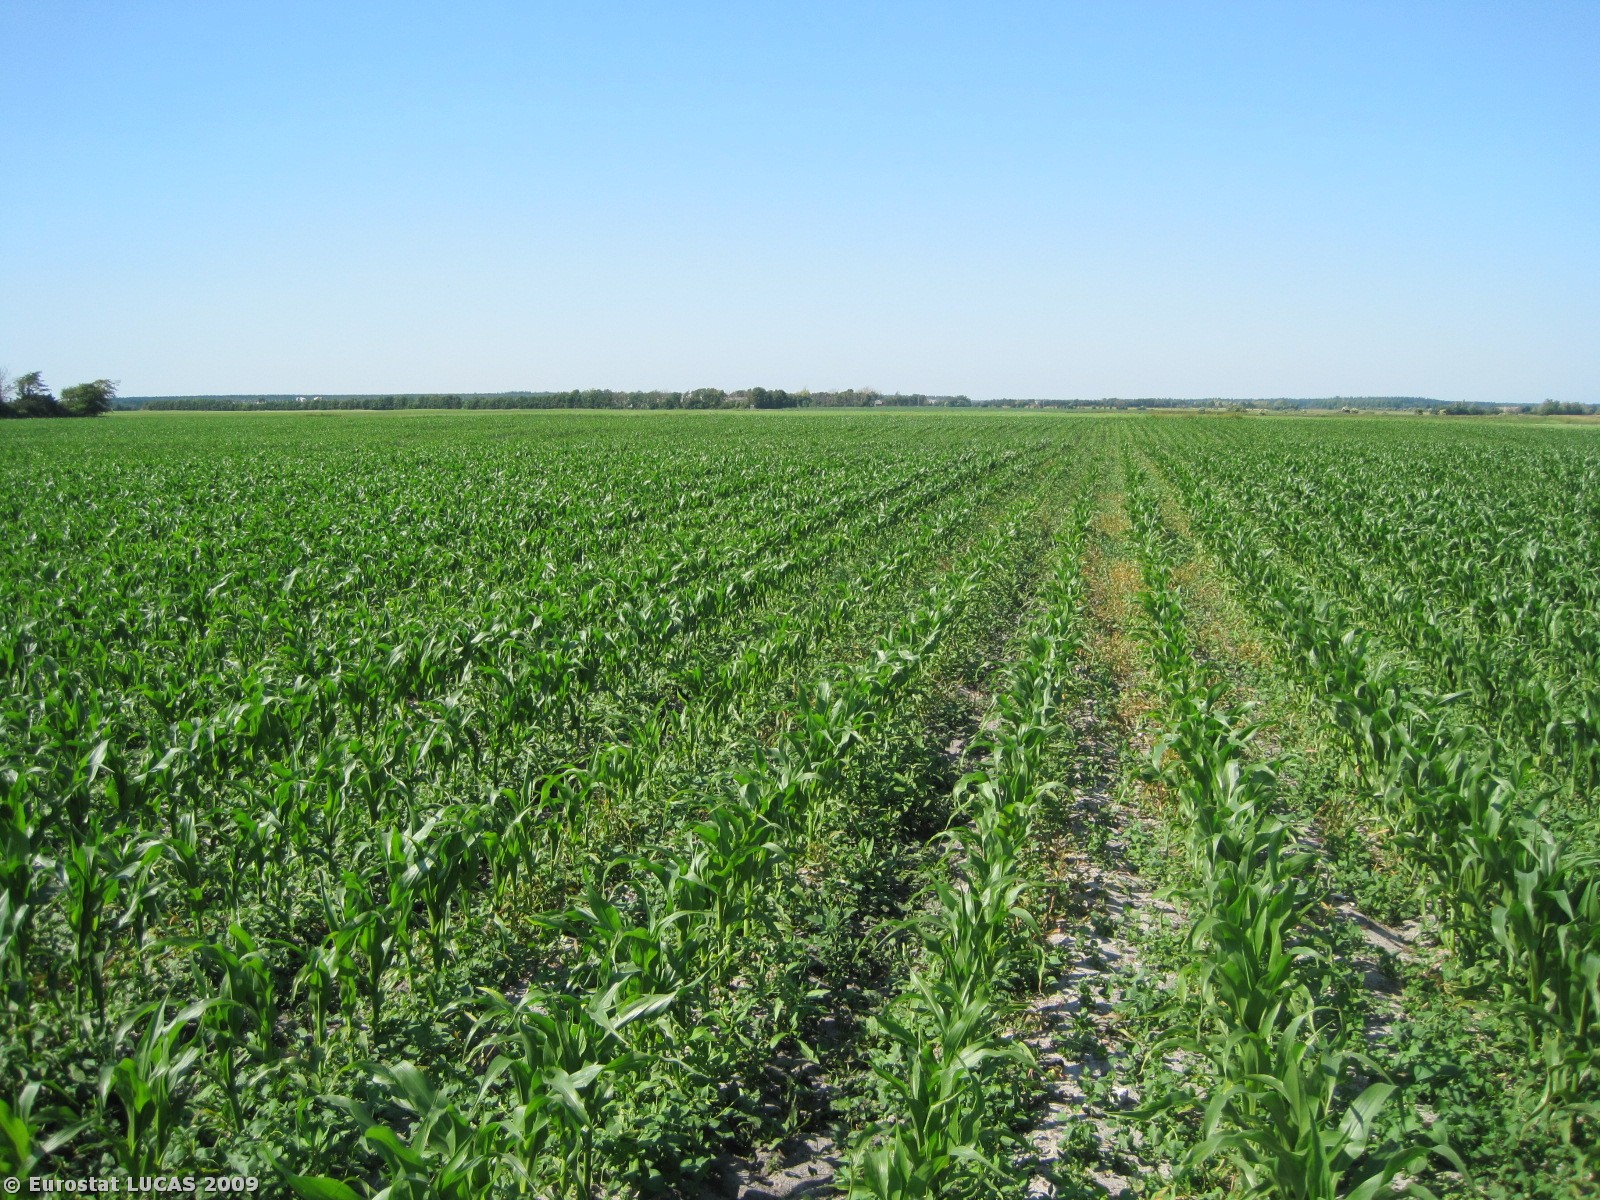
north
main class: Cropland
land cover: Maize
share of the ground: 25 - 50 %
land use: Agriculture (excluding fallow land and kitchen gardens)
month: July
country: DK
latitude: 56.3939
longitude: 8.4305
